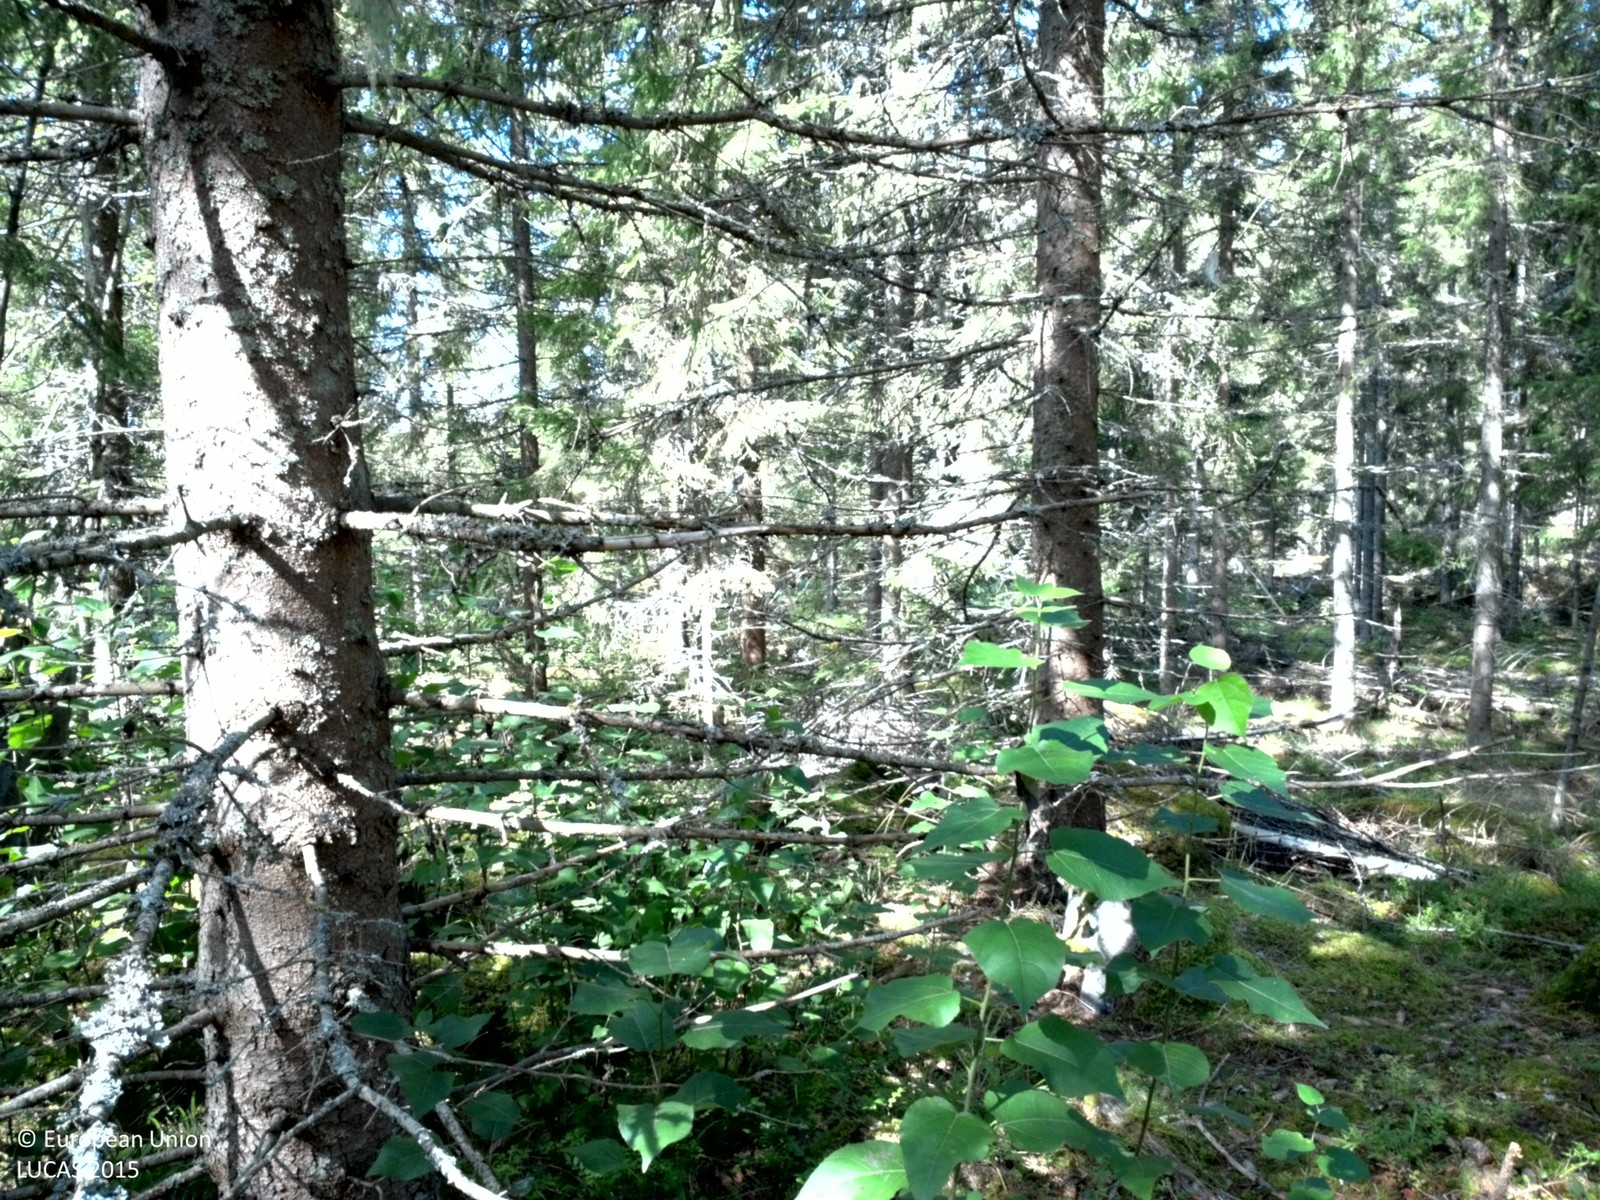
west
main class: Woodland
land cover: Spruce dominated coniferous woodland
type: boreal forest
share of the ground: > 75 %
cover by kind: coniferous forest trees 75 %, lichens and mosses 15 %, broadleaved forest trees 5 %, shrubs 5 %
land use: Forestry
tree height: > 5 m
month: August
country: SE
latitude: 59.8954
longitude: 16.3001
